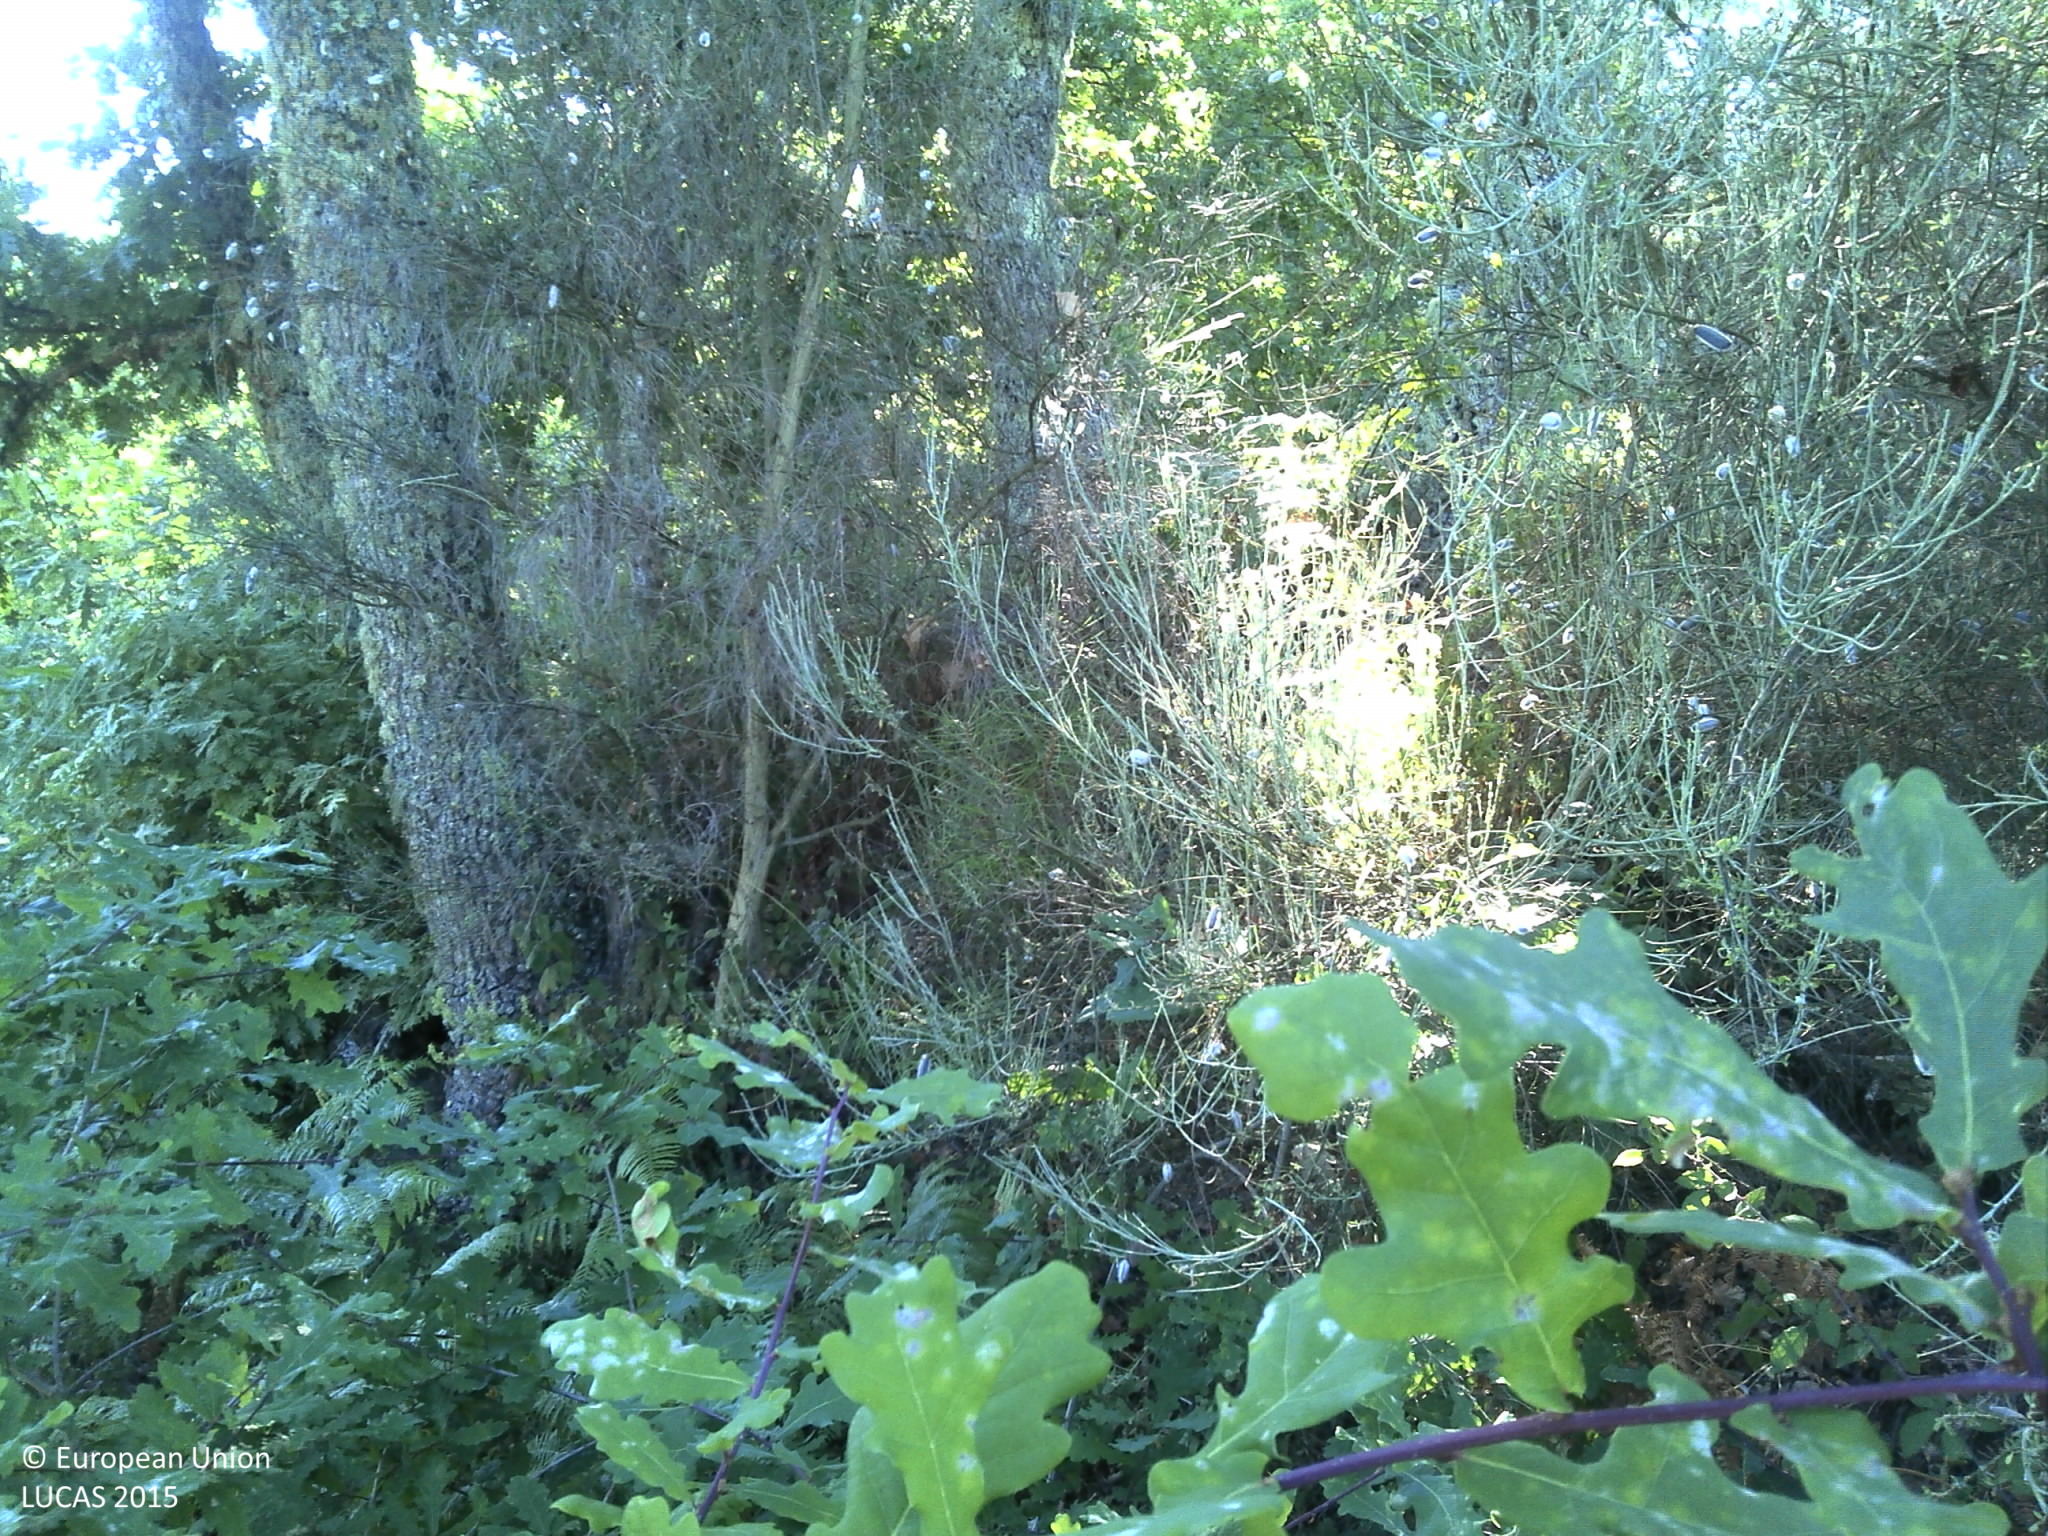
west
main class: Woodland
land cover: Broadleaved woodland
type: thermophilous deciduous forest
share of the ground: > 75 %
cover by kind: broadleaved forest trees 75 %, shrubs 10 %, unconsolidated bare surface 10 %, herbaceous plants 5 %
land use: Forestry
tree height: > 5 m
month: July
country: PT
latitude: 41.6260
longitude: -7.7438
